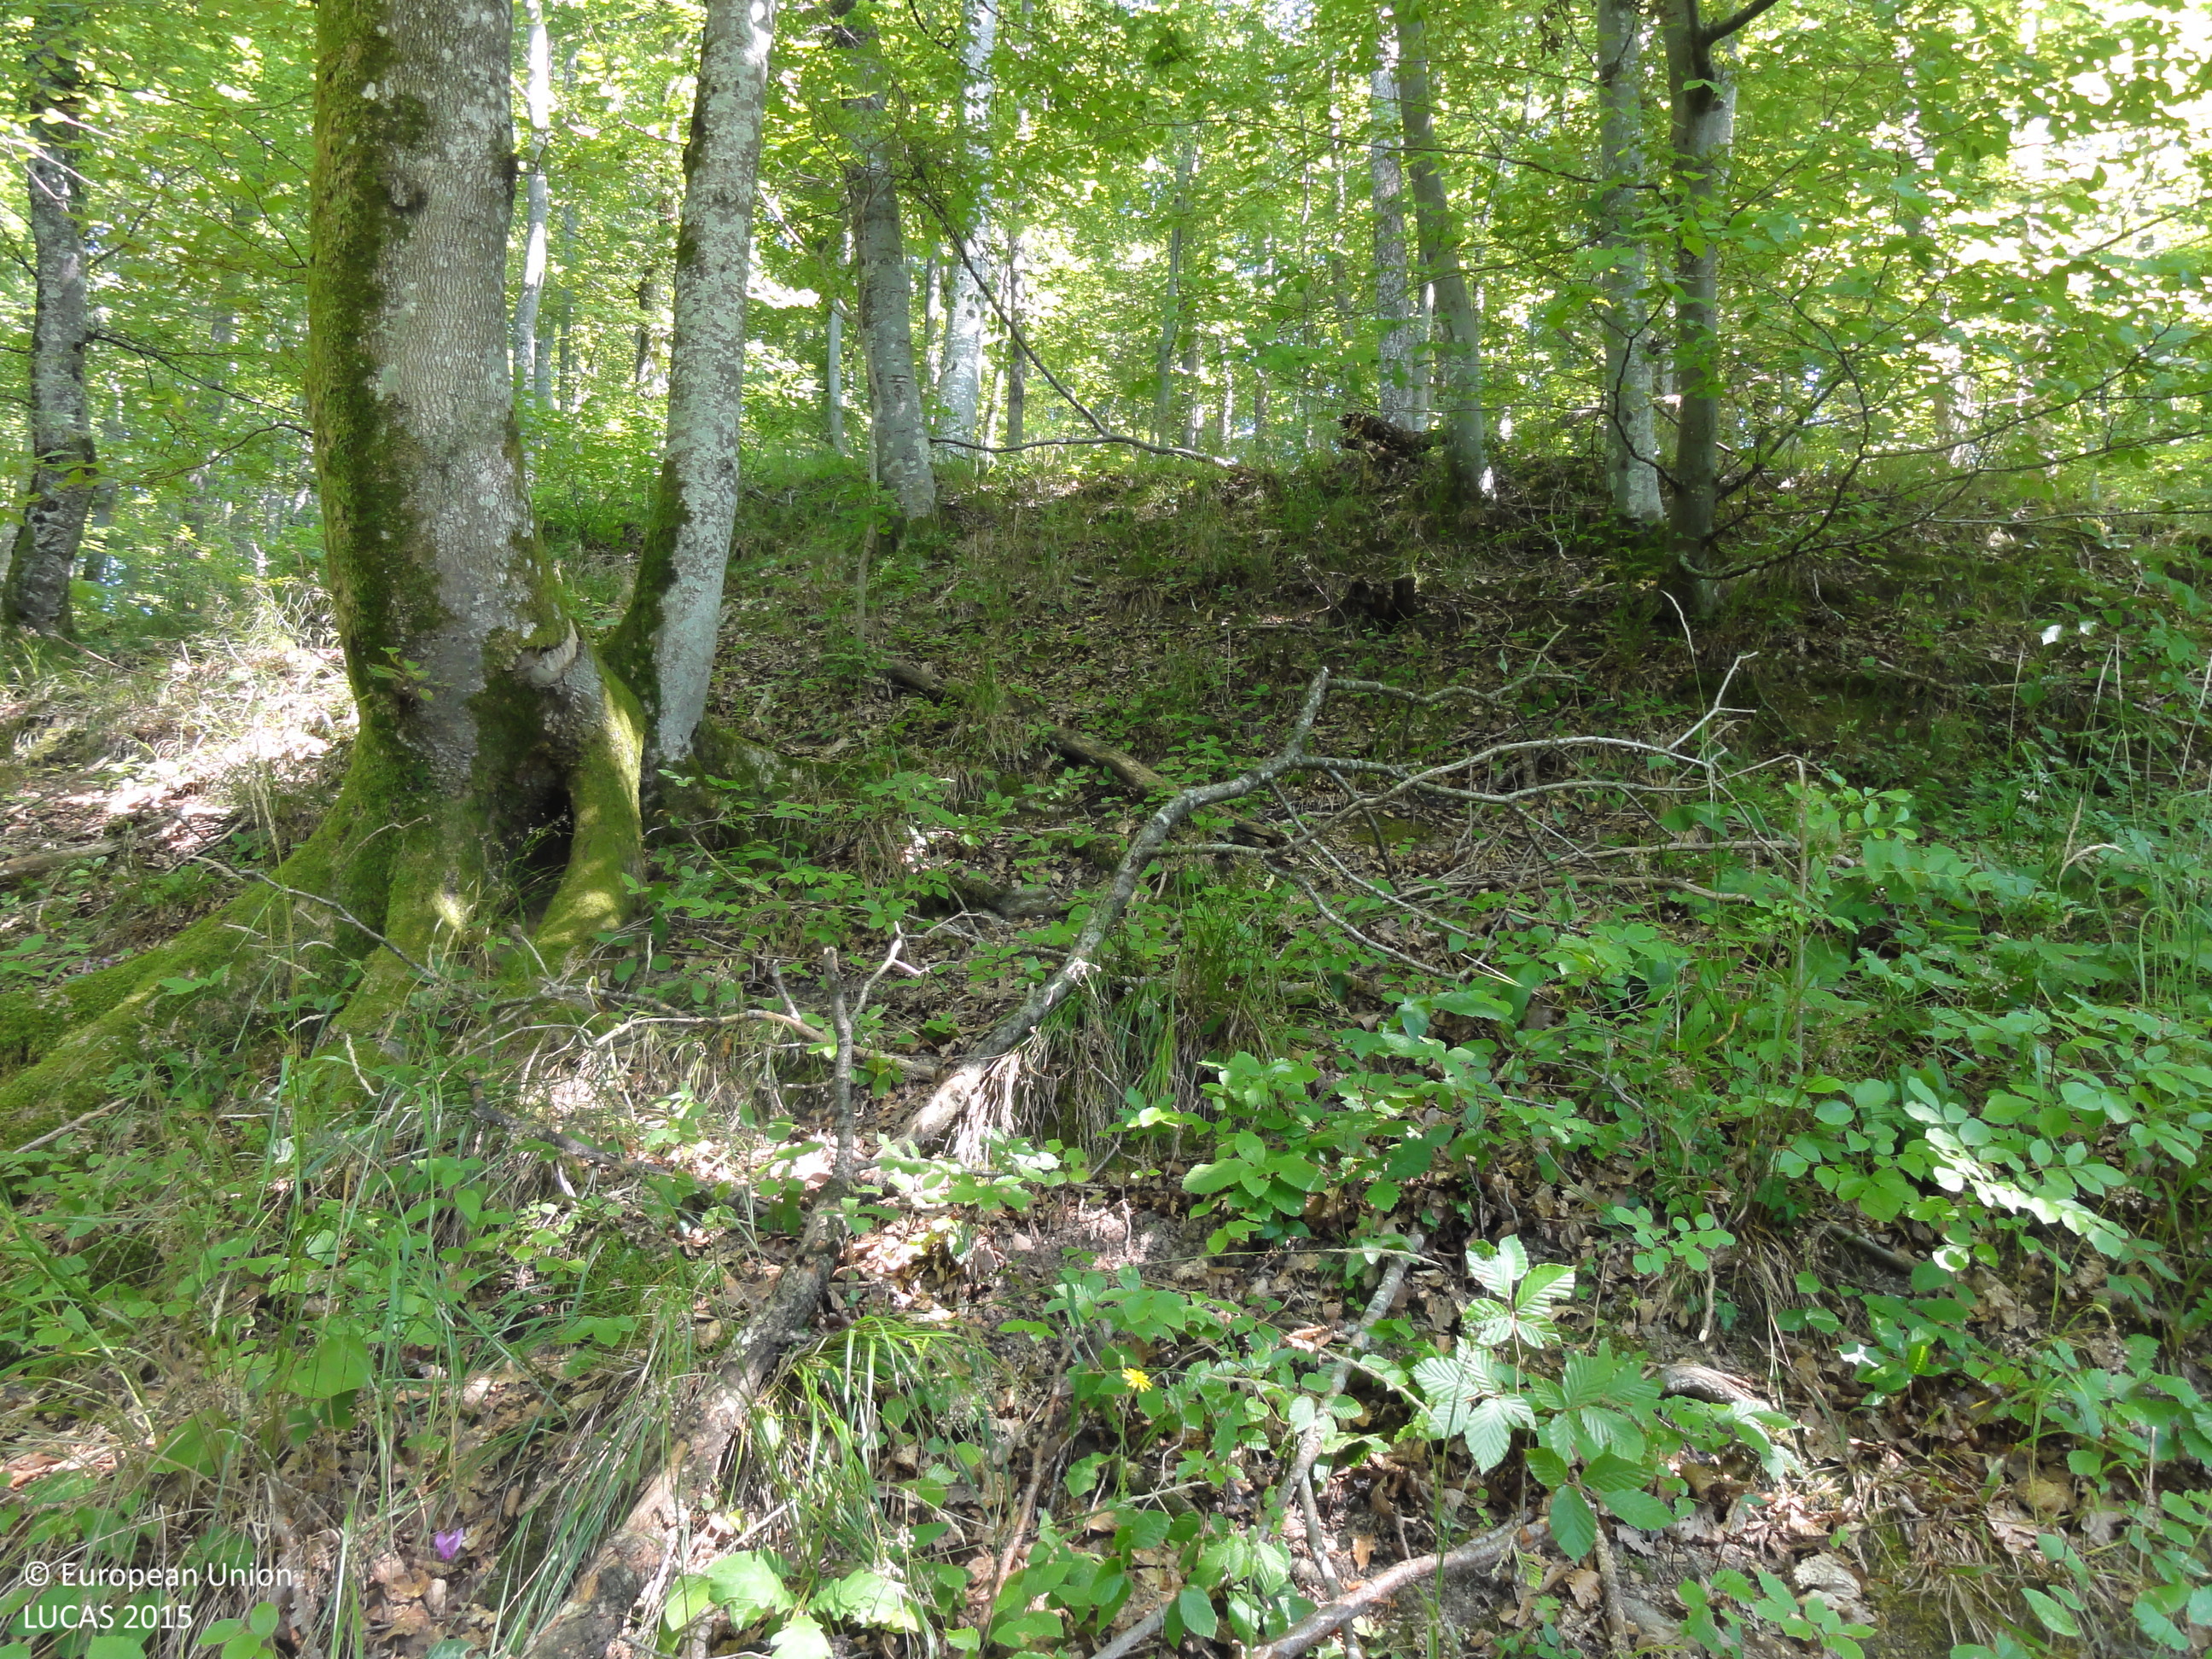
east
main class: Woodland
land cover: Broadleaved woodland
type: beech forest
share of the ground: > 75 %
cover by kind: broadleaved forest trees 100 %
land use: Forestry
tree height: > 5 m
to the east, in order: Broadleaved woodland; Other bare soil; Shrubland with sparse tree cover; Grassland without tree/shrub cover; Broadleaved woodland; Tracks; Grassland without tree/shrub cover; Broadleaved woodland
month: August
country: SI
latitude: 45.9796
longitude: 15.0437
